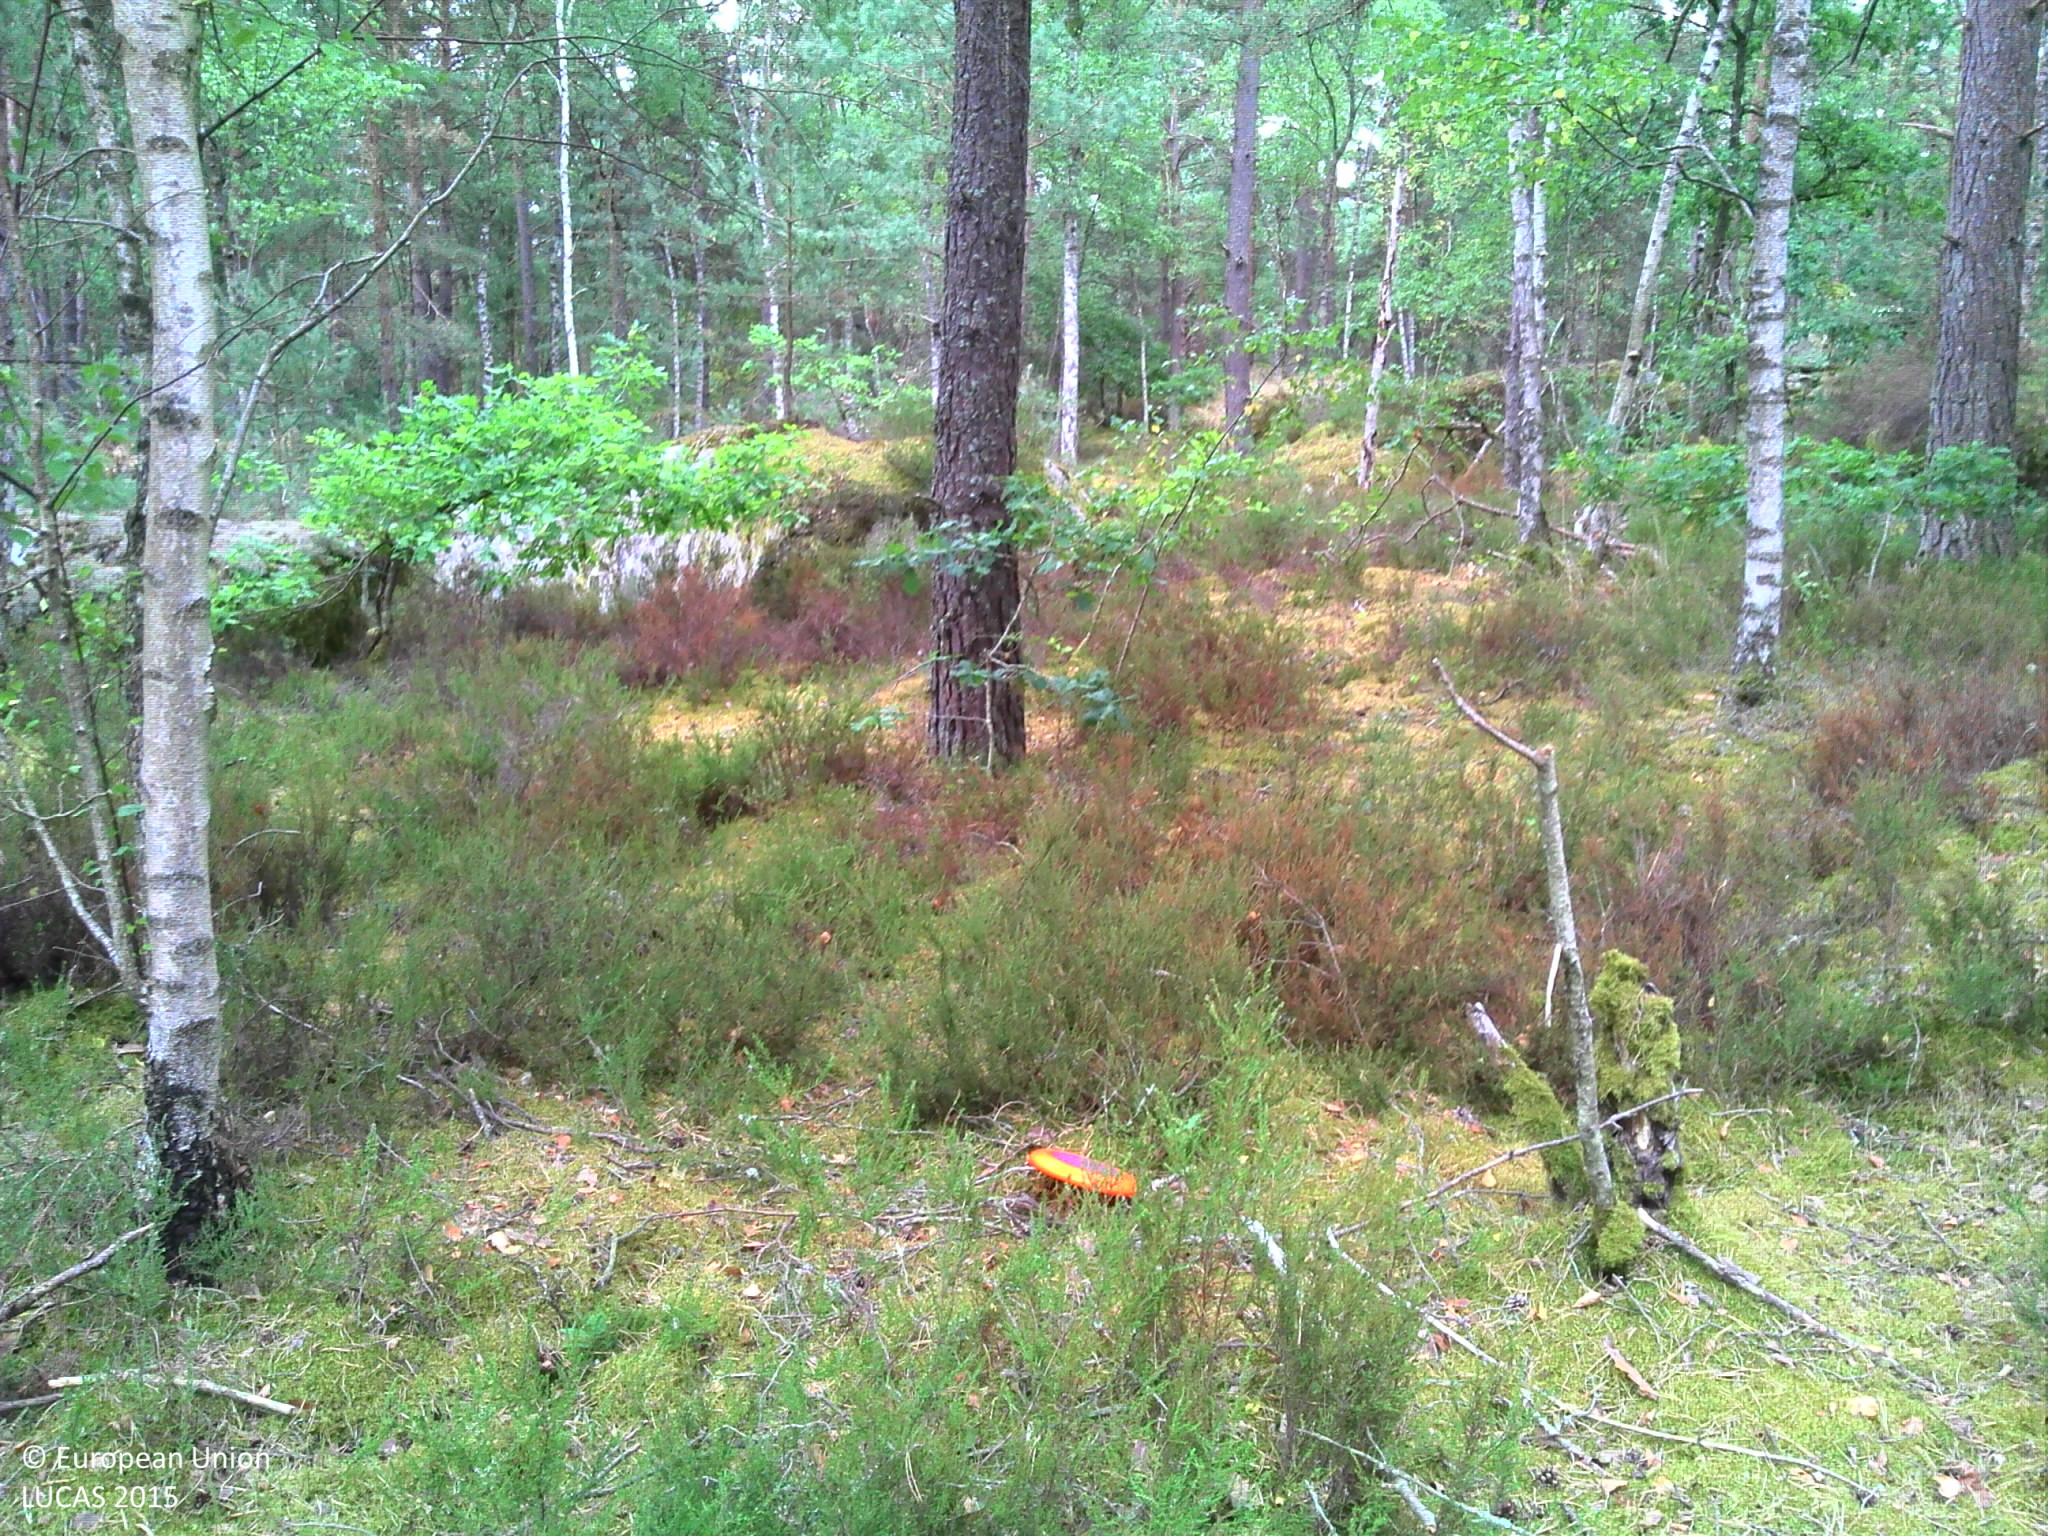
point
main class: Woodland
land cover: Pine dominated mixed woodland
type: non-riverine alder, birch or aspen forest
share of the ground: > 75 %
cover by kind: lichens and mosses 40 %, coniferous forest trees 30 %, shrubs 20 %, broadleaved forest trees 10 %
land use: Forestry
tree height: > 5 m
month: August
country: FR
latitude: 48.3671
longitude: 2.5251
